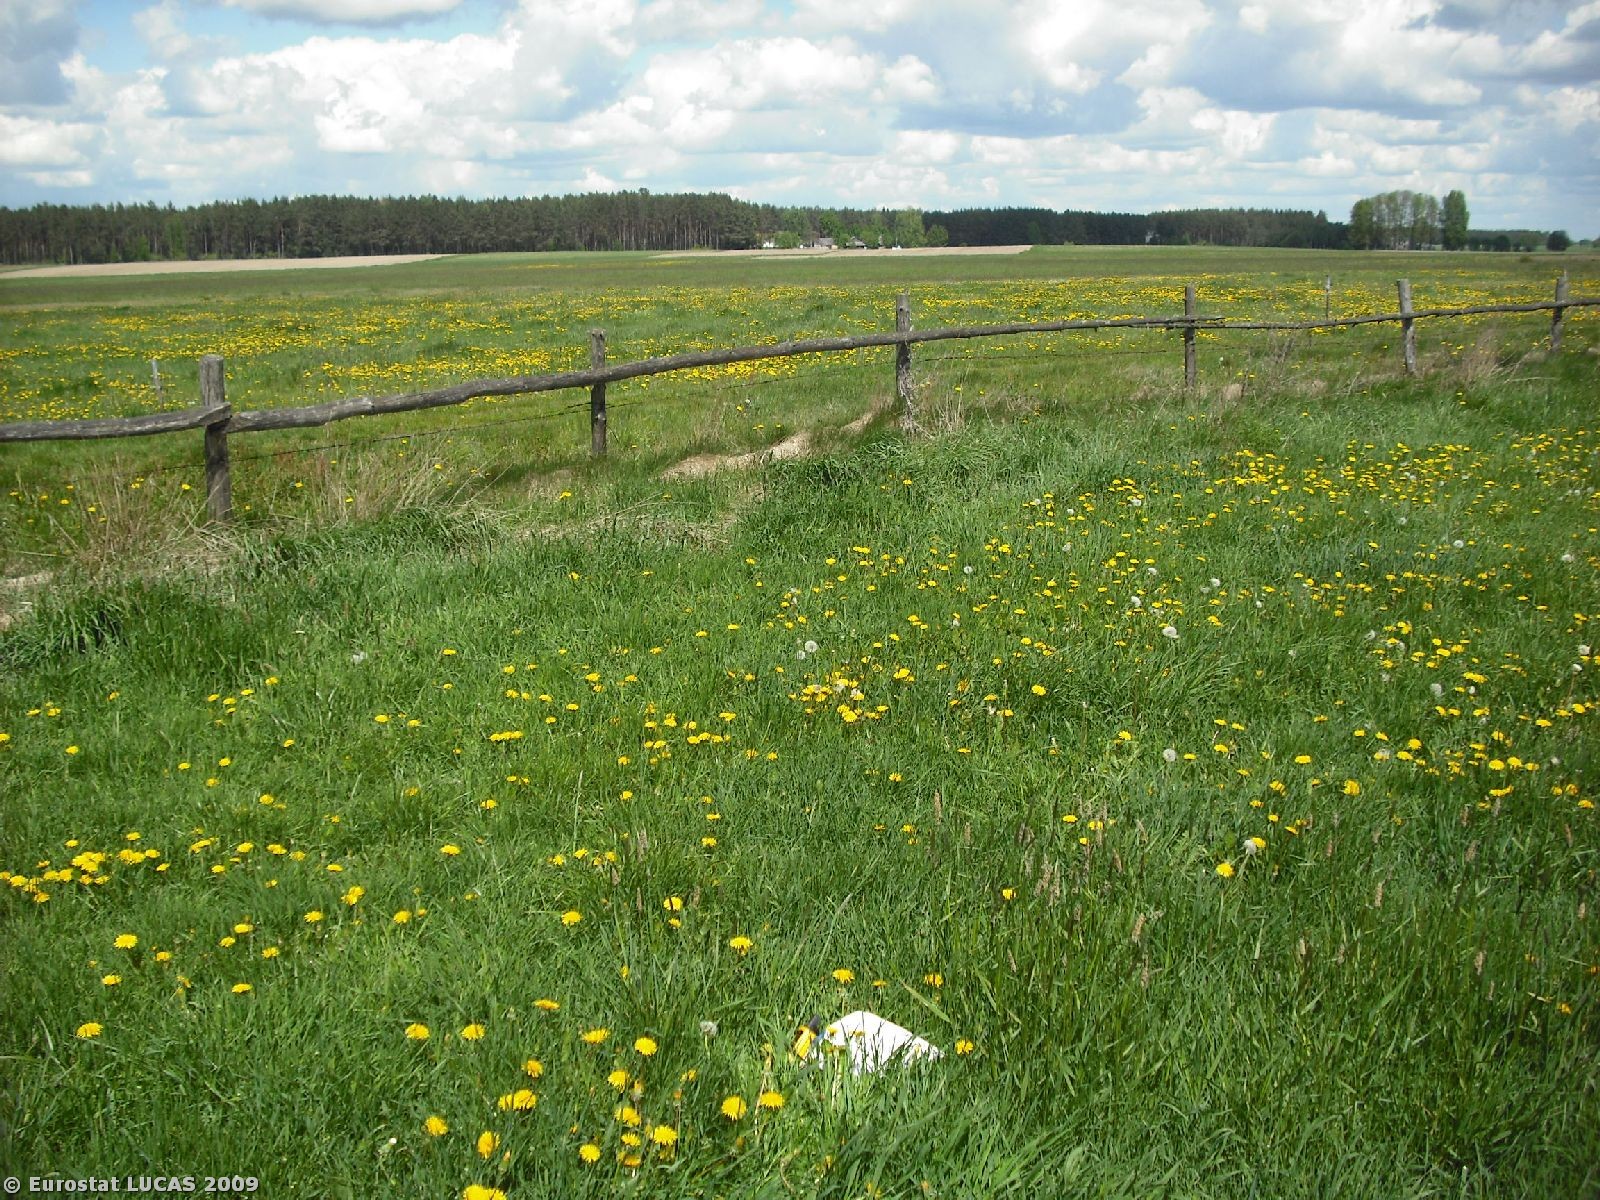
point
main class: Grassland
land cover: Grassland without tree/shrub cover
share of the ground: > 75 %
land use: Agriculture (excluding fallow land and kitchen gardens)
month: May
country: PL
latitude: 52.9903
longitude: 22.4750
